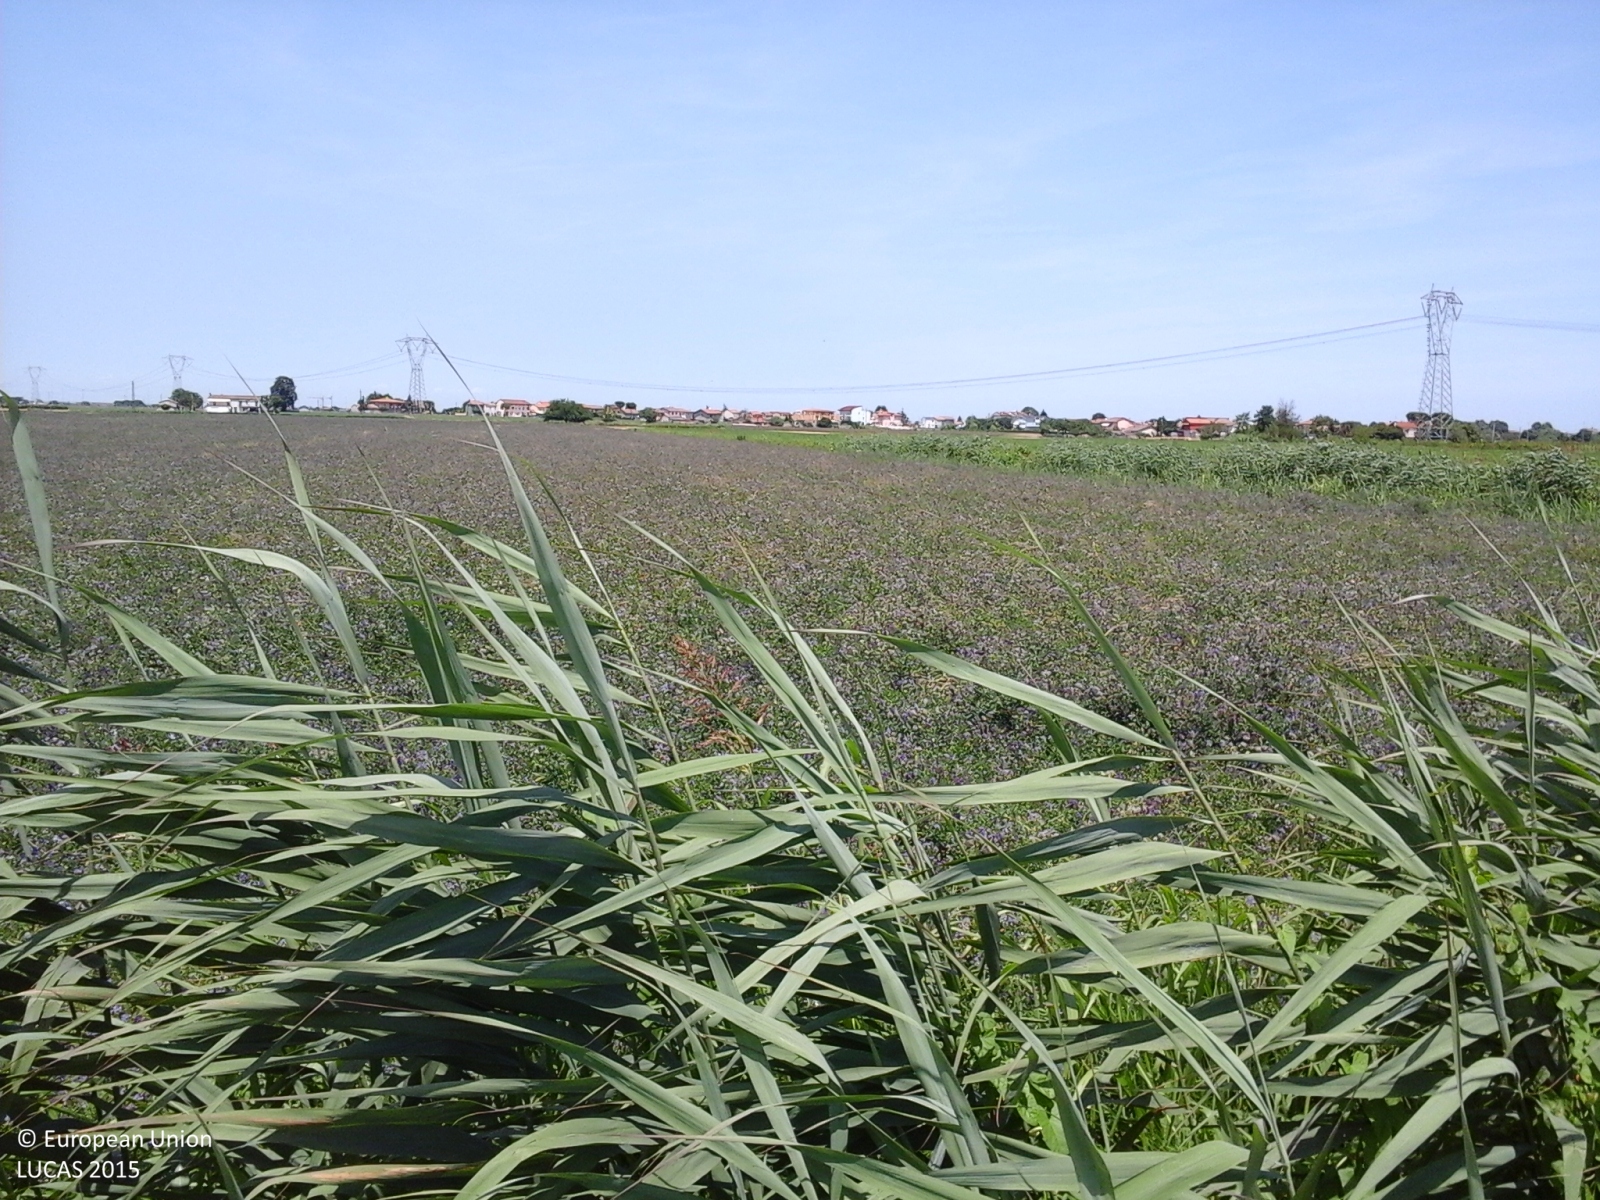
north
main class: Cropland
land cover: Lucerne
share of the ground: > 75 %
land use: Agriculture (excluding fallow land and kitchen gardens)
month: June
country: IT
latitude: 44.1614
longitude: 12.3581
